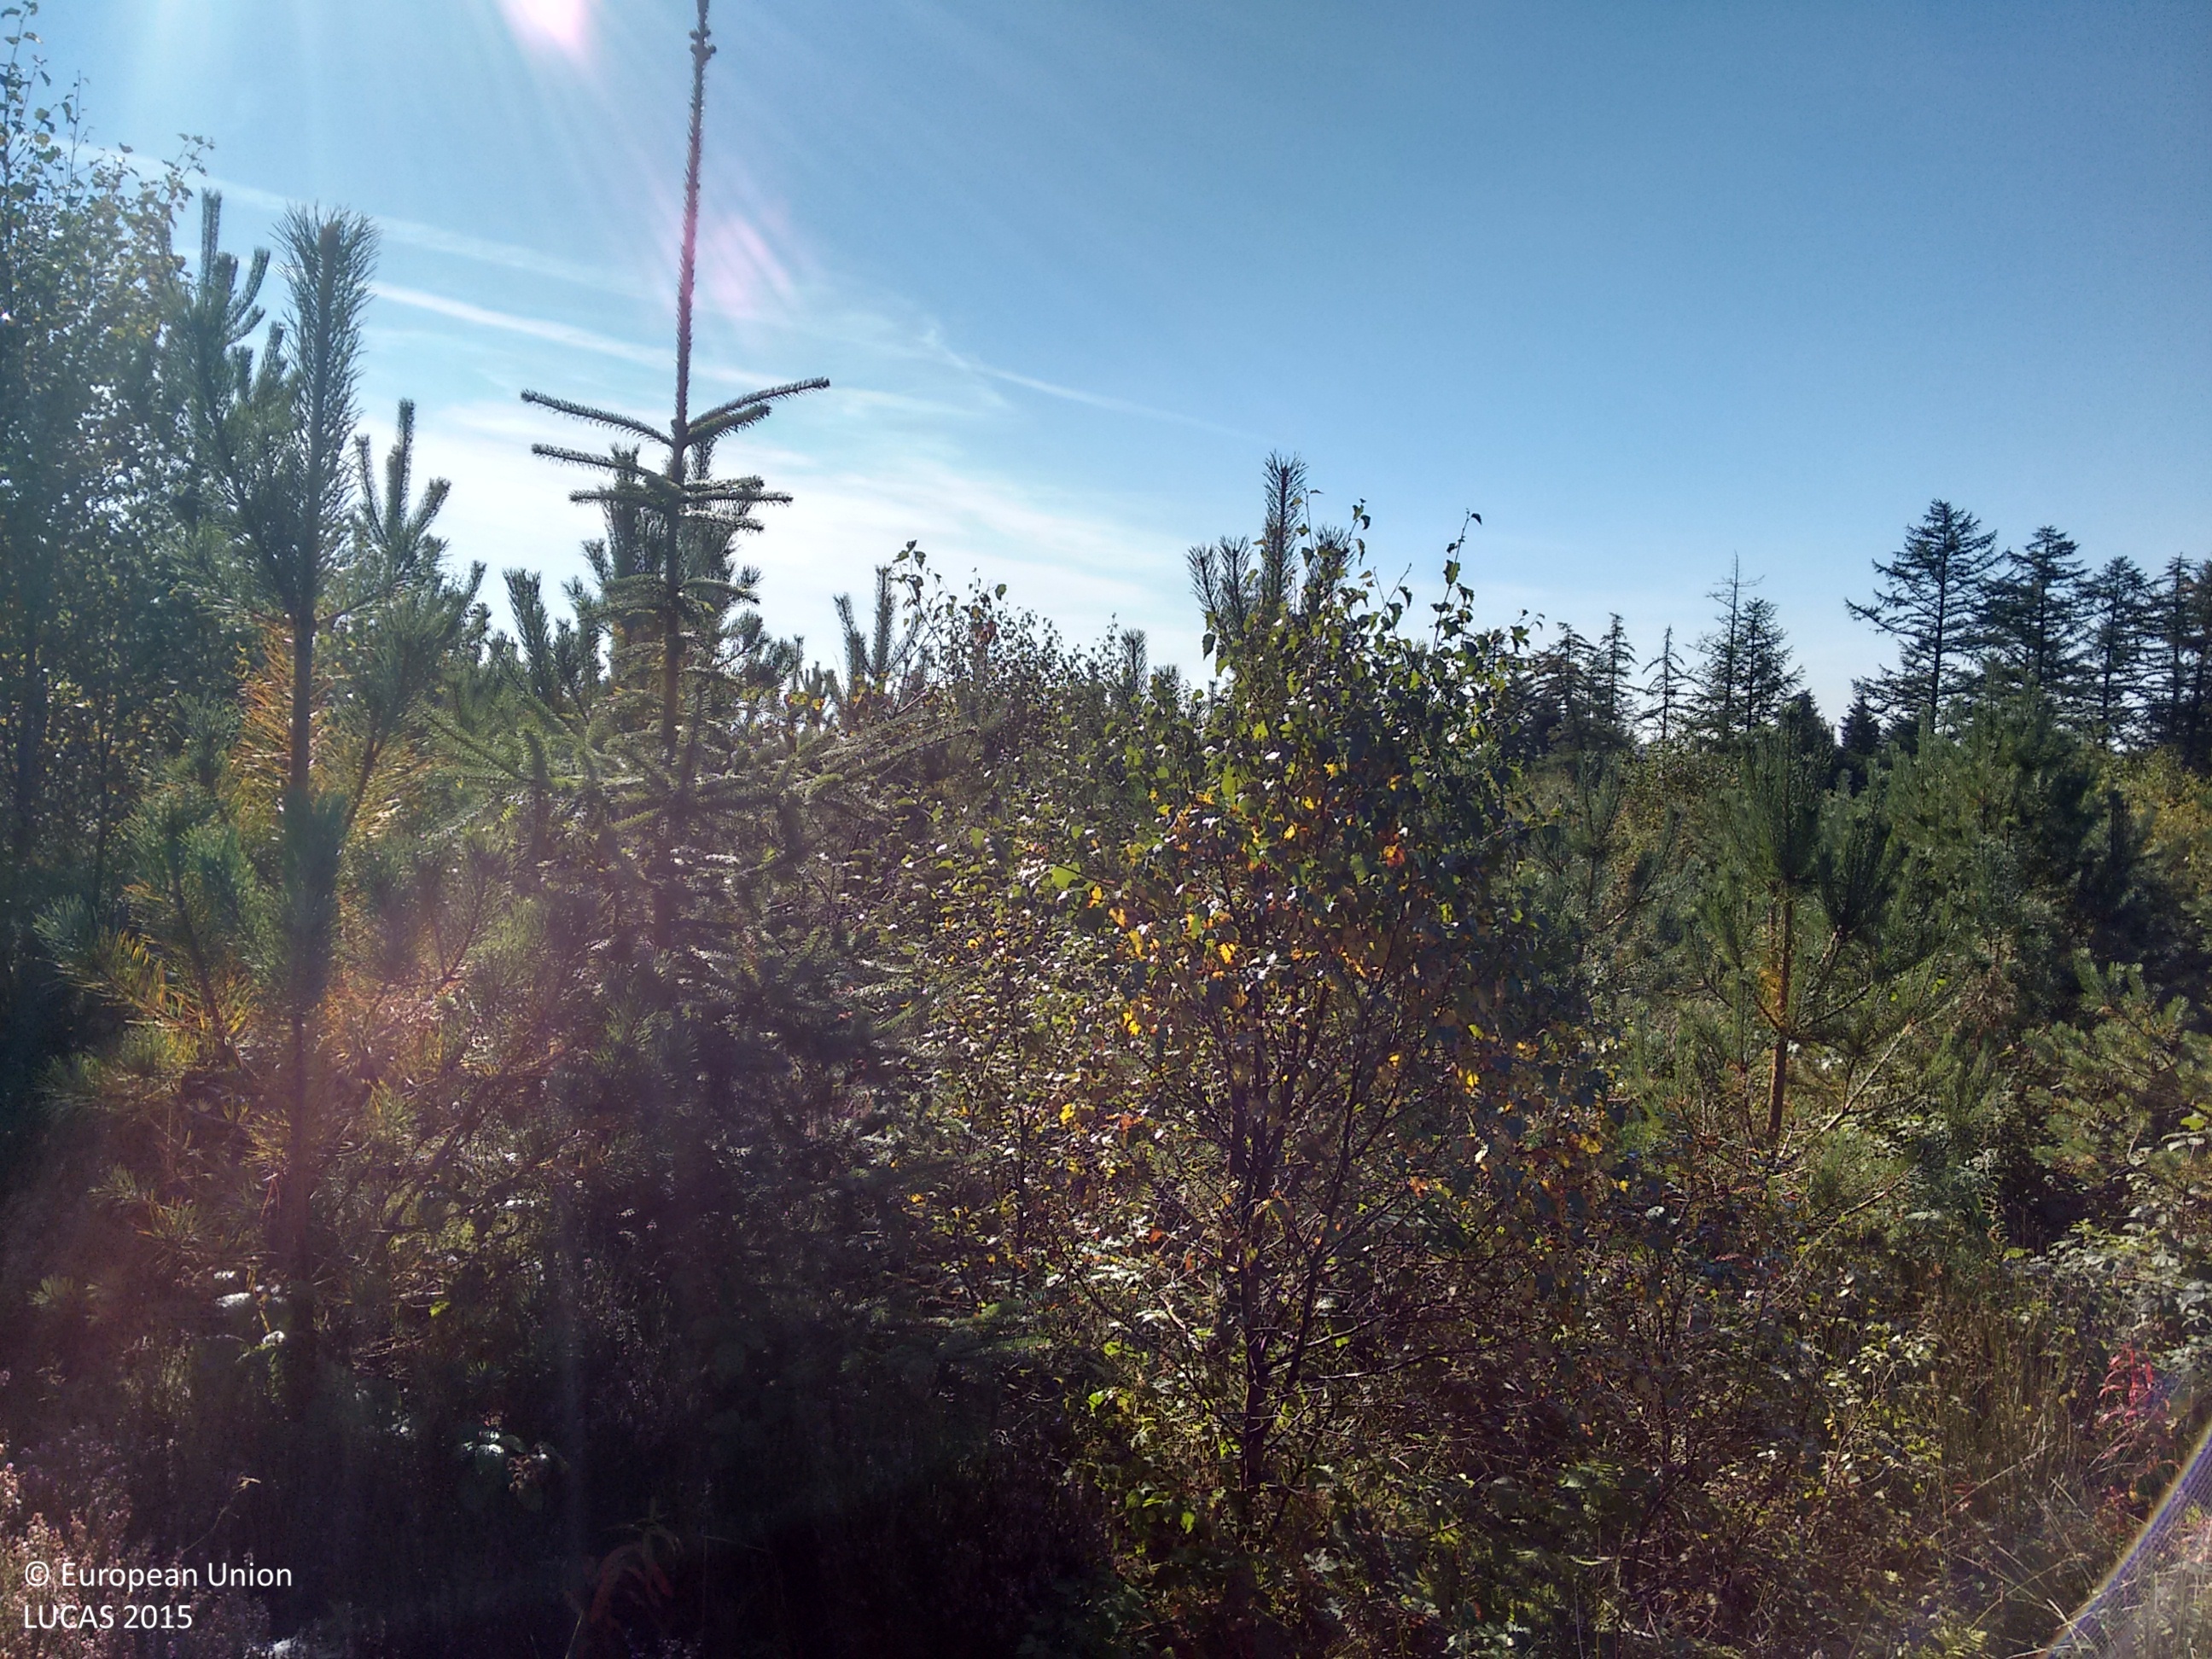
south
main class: Woodland
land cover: Pine dominated mixed woodland
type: exotic forest
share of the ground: > 75 %
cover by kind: coniferous forest trees 60 %, broadleaved forest trees 30 %, shrubs 10 %
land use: Forestry
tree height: < 5 m
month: September
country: GB
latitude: 56.0921
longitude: -4.4827
